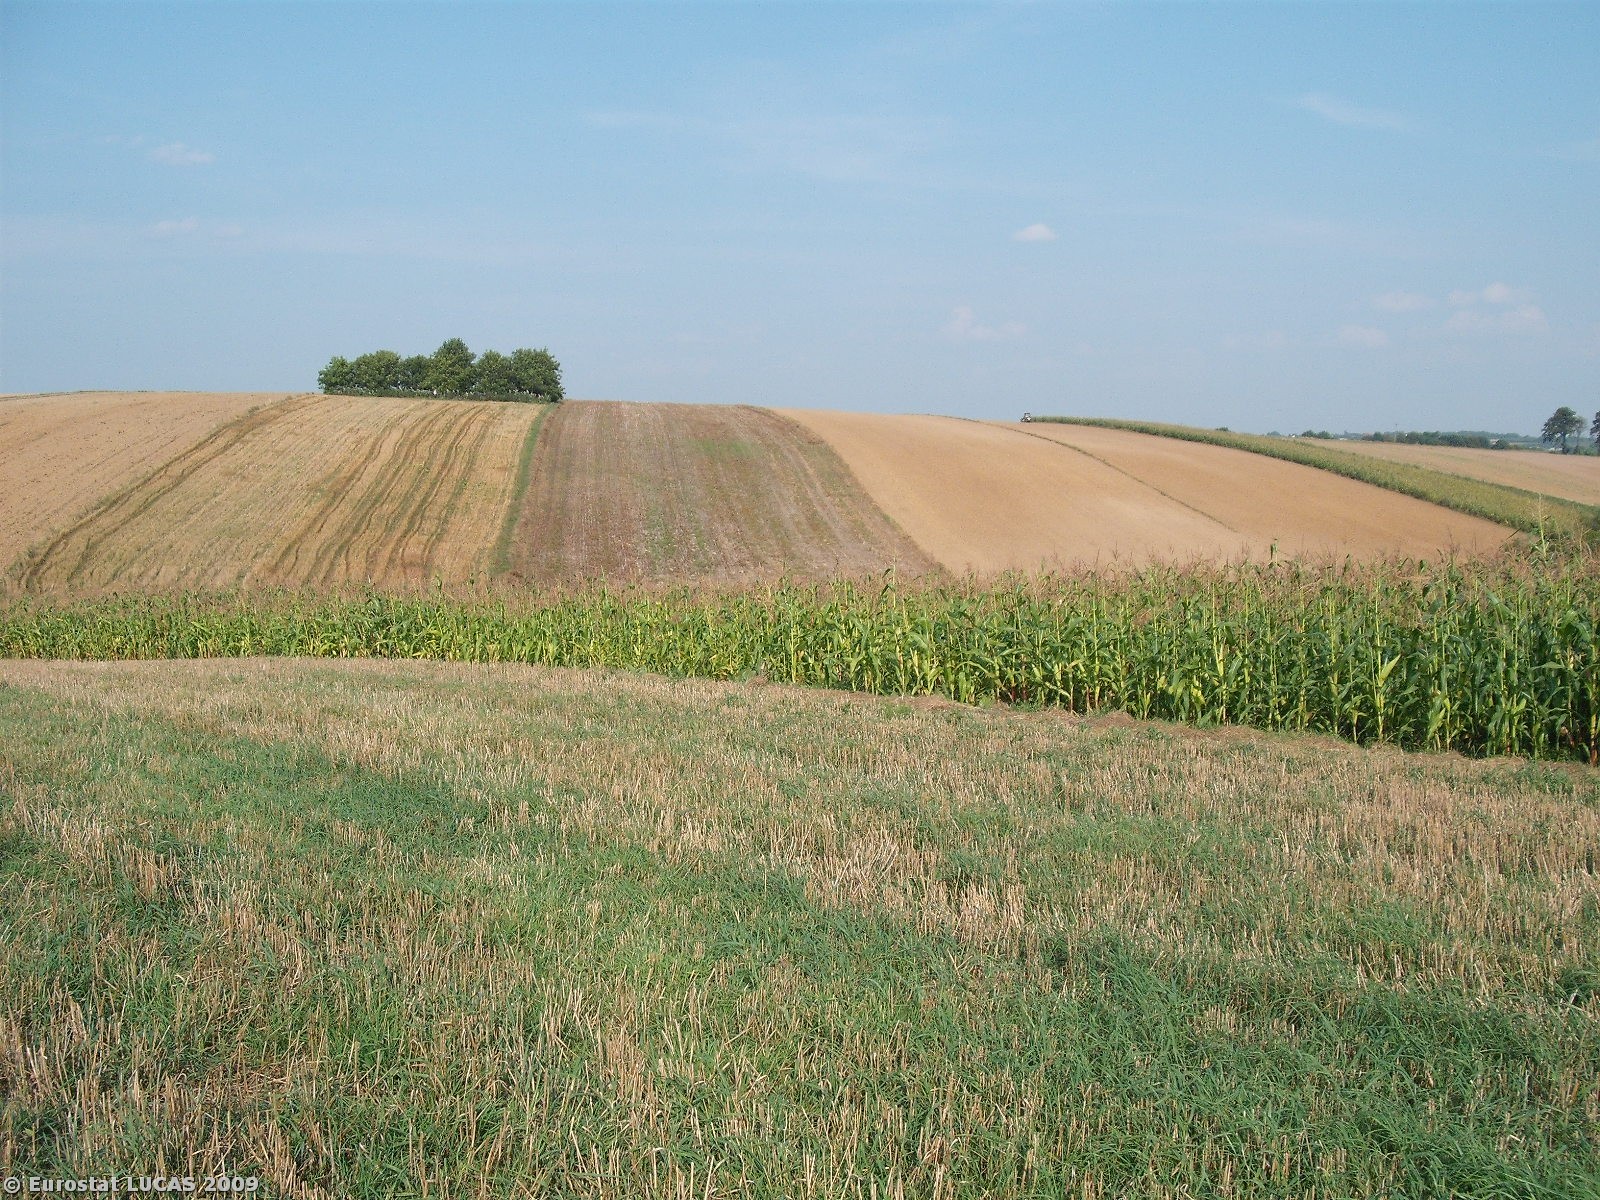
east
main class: Cropland
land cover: Common wheat
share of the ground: < 10 %
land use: Agriculture (excluding fallow land and kitchen gardens)
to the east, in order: Common wheat; Grass margins; Maize; Grassland without tree/shrub cover; Tracks; Spontaneously vegetated surfaces; Bare land
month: August
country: PL
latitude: 49.9561
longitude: 22.4273
